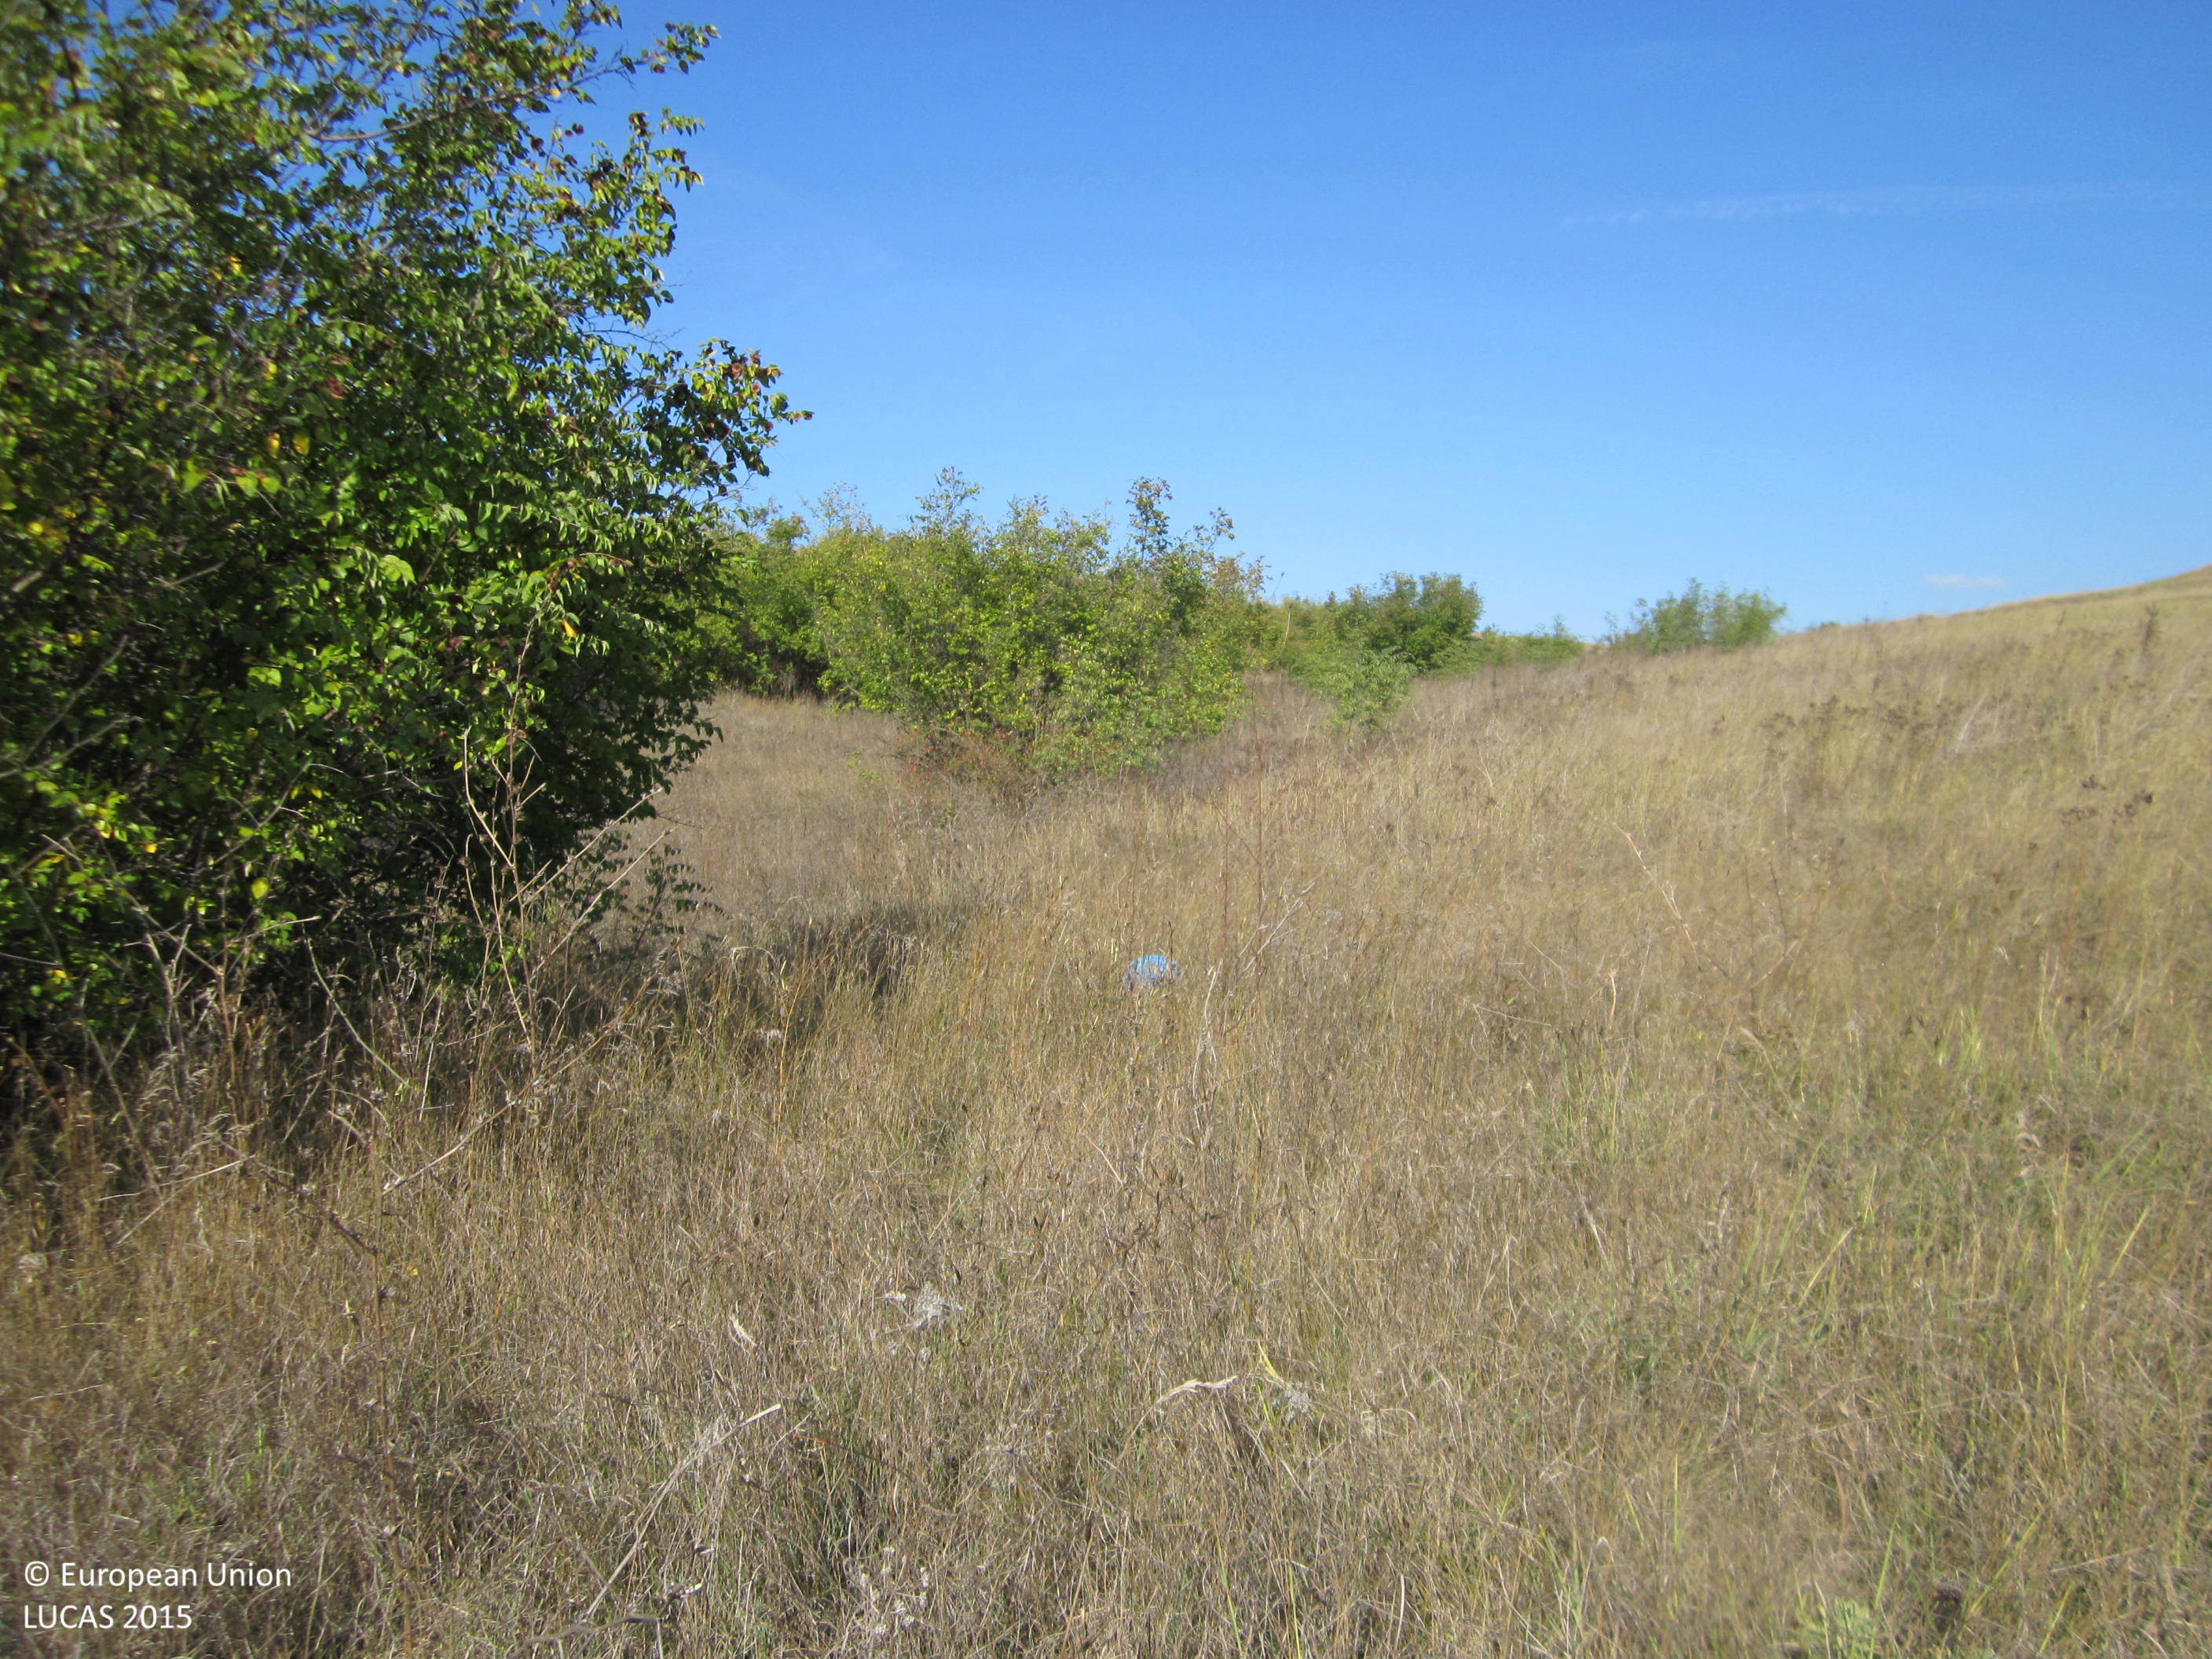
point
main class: Grassland
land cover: Grassland with sparse tree/shrub cover
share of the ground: > 75 %
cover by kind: herbaceous plants 85 %, shrubs 10 %, broadleaved forest trees 5 %
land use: Agriculture (excluding fallow land and kitchen gardens)
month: October
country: BG
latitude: 42.6518
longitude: 26.8258
